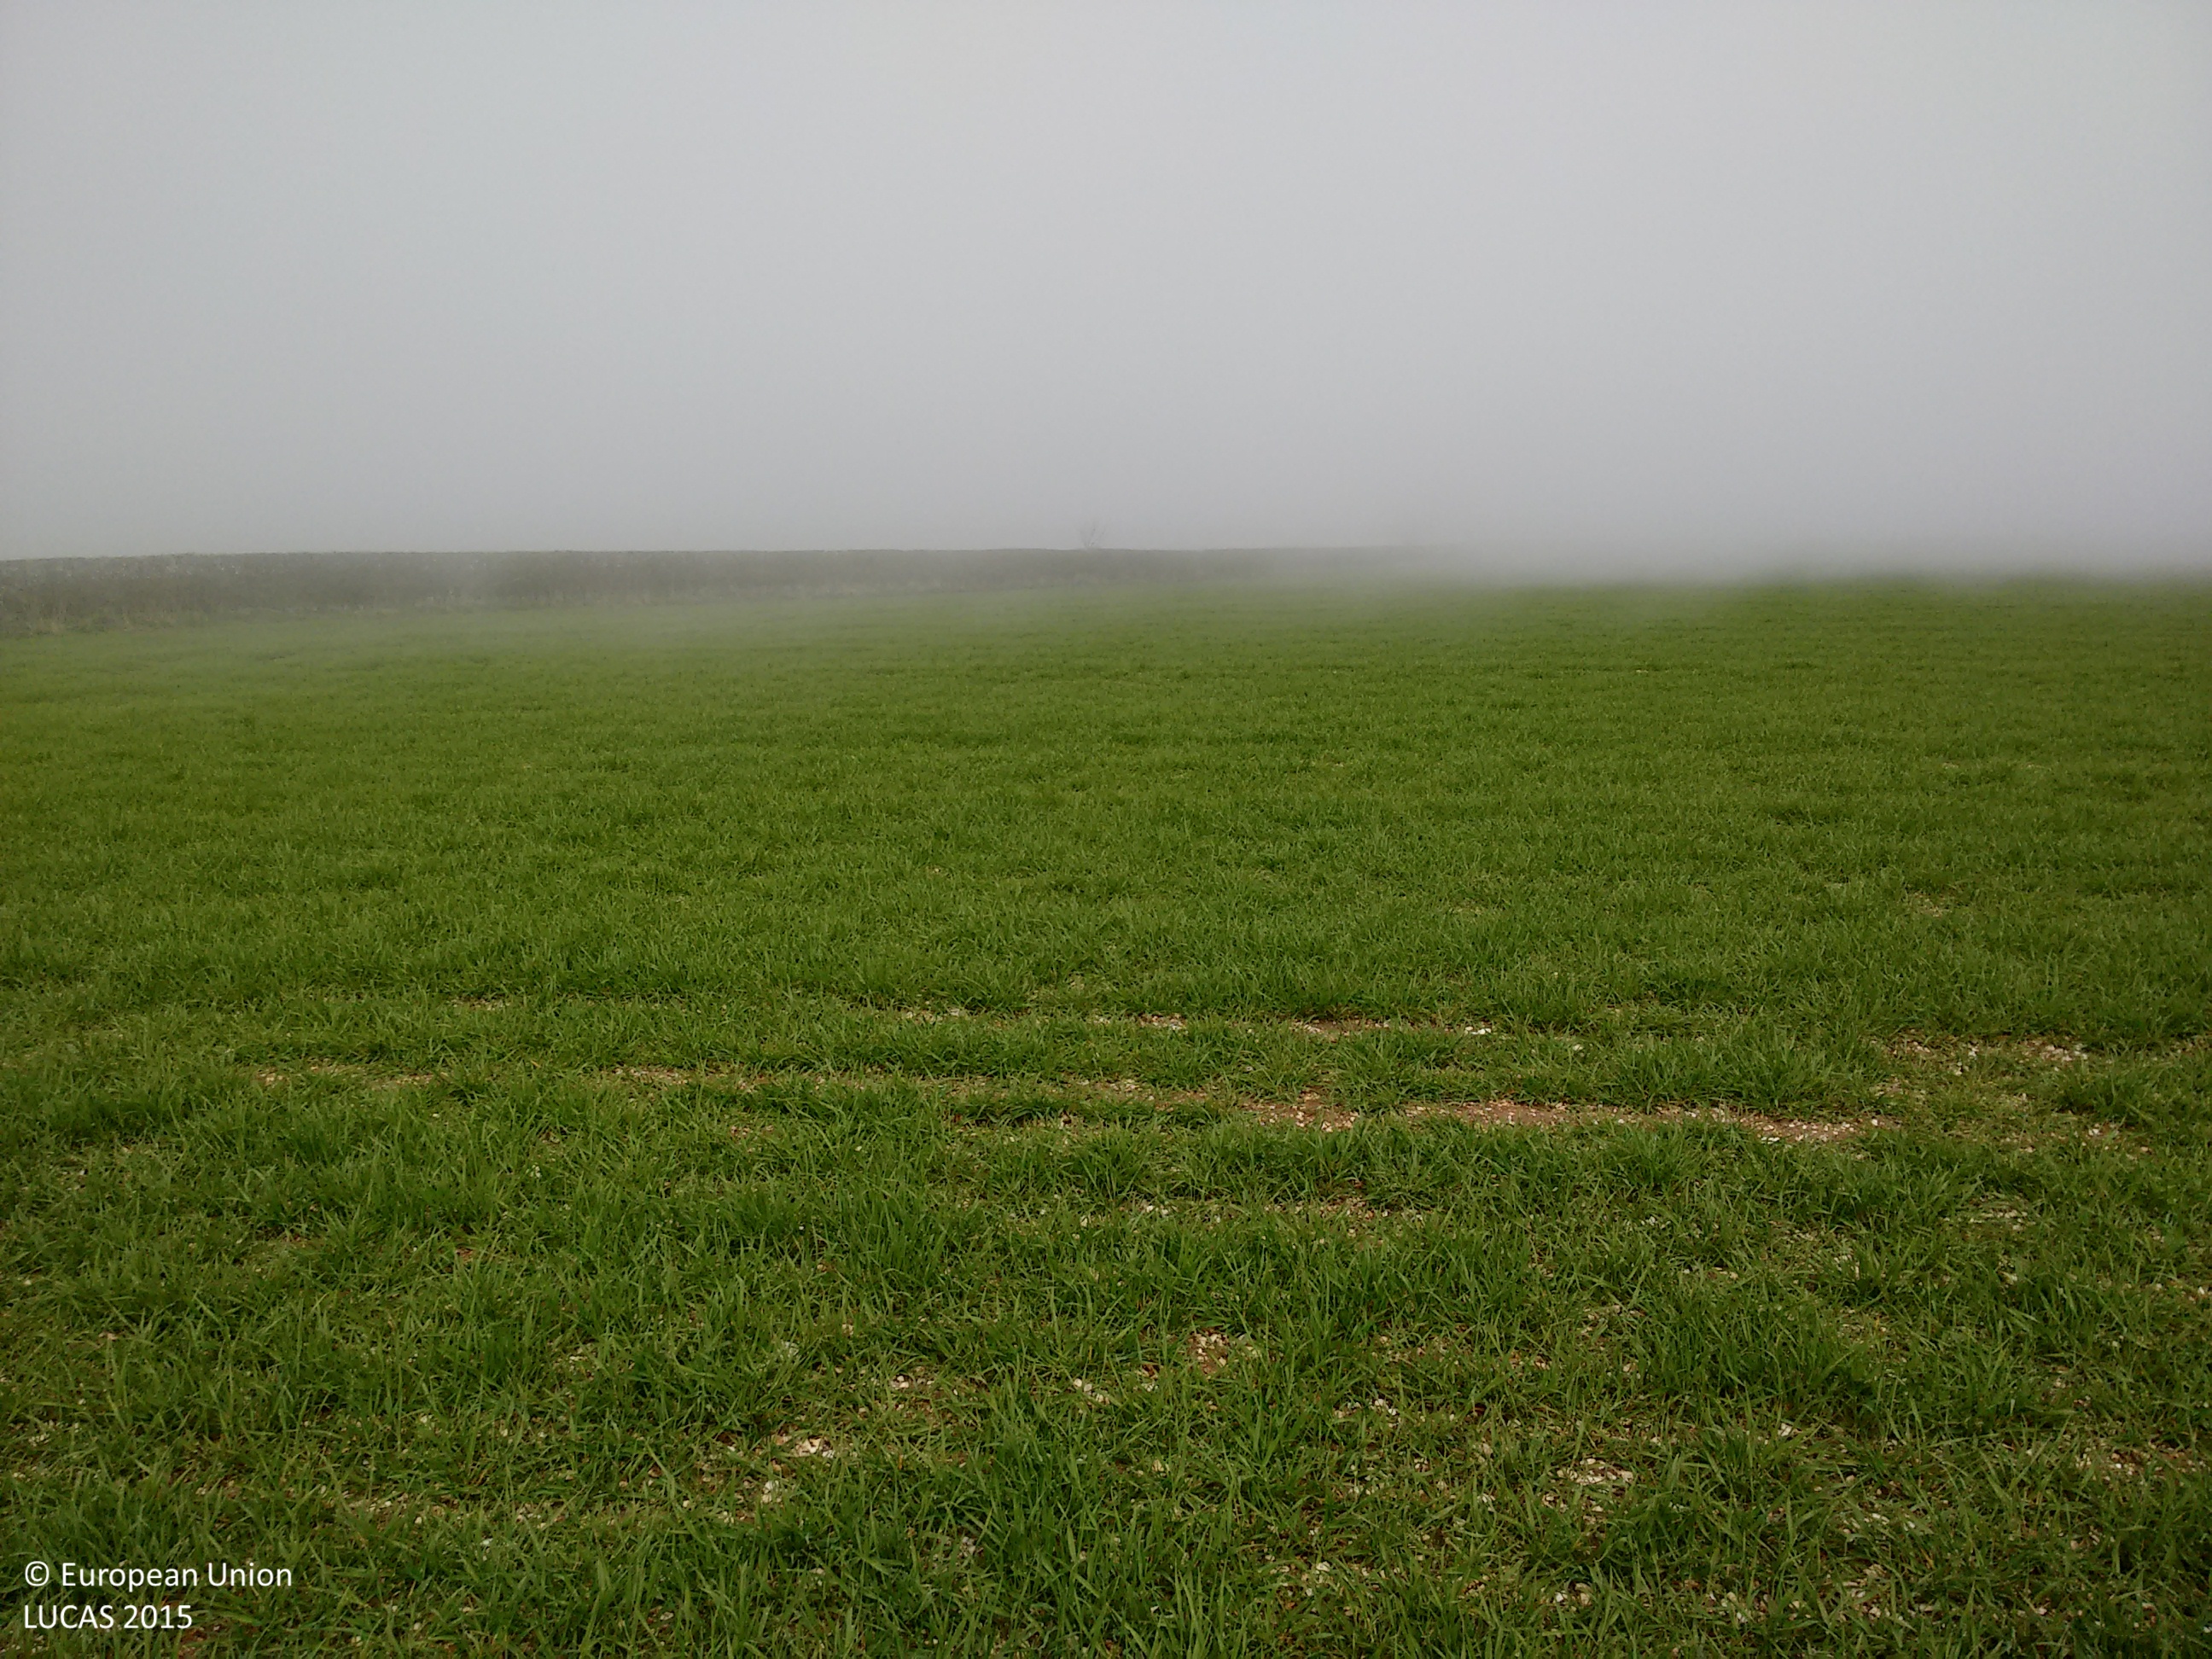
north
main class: Cropland
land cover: Barley
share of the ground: > 75 %
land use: Agriculture (excluding fallow land and kitchen gardens)
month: April
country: GB
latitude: 53.9914
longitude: -0.7622
